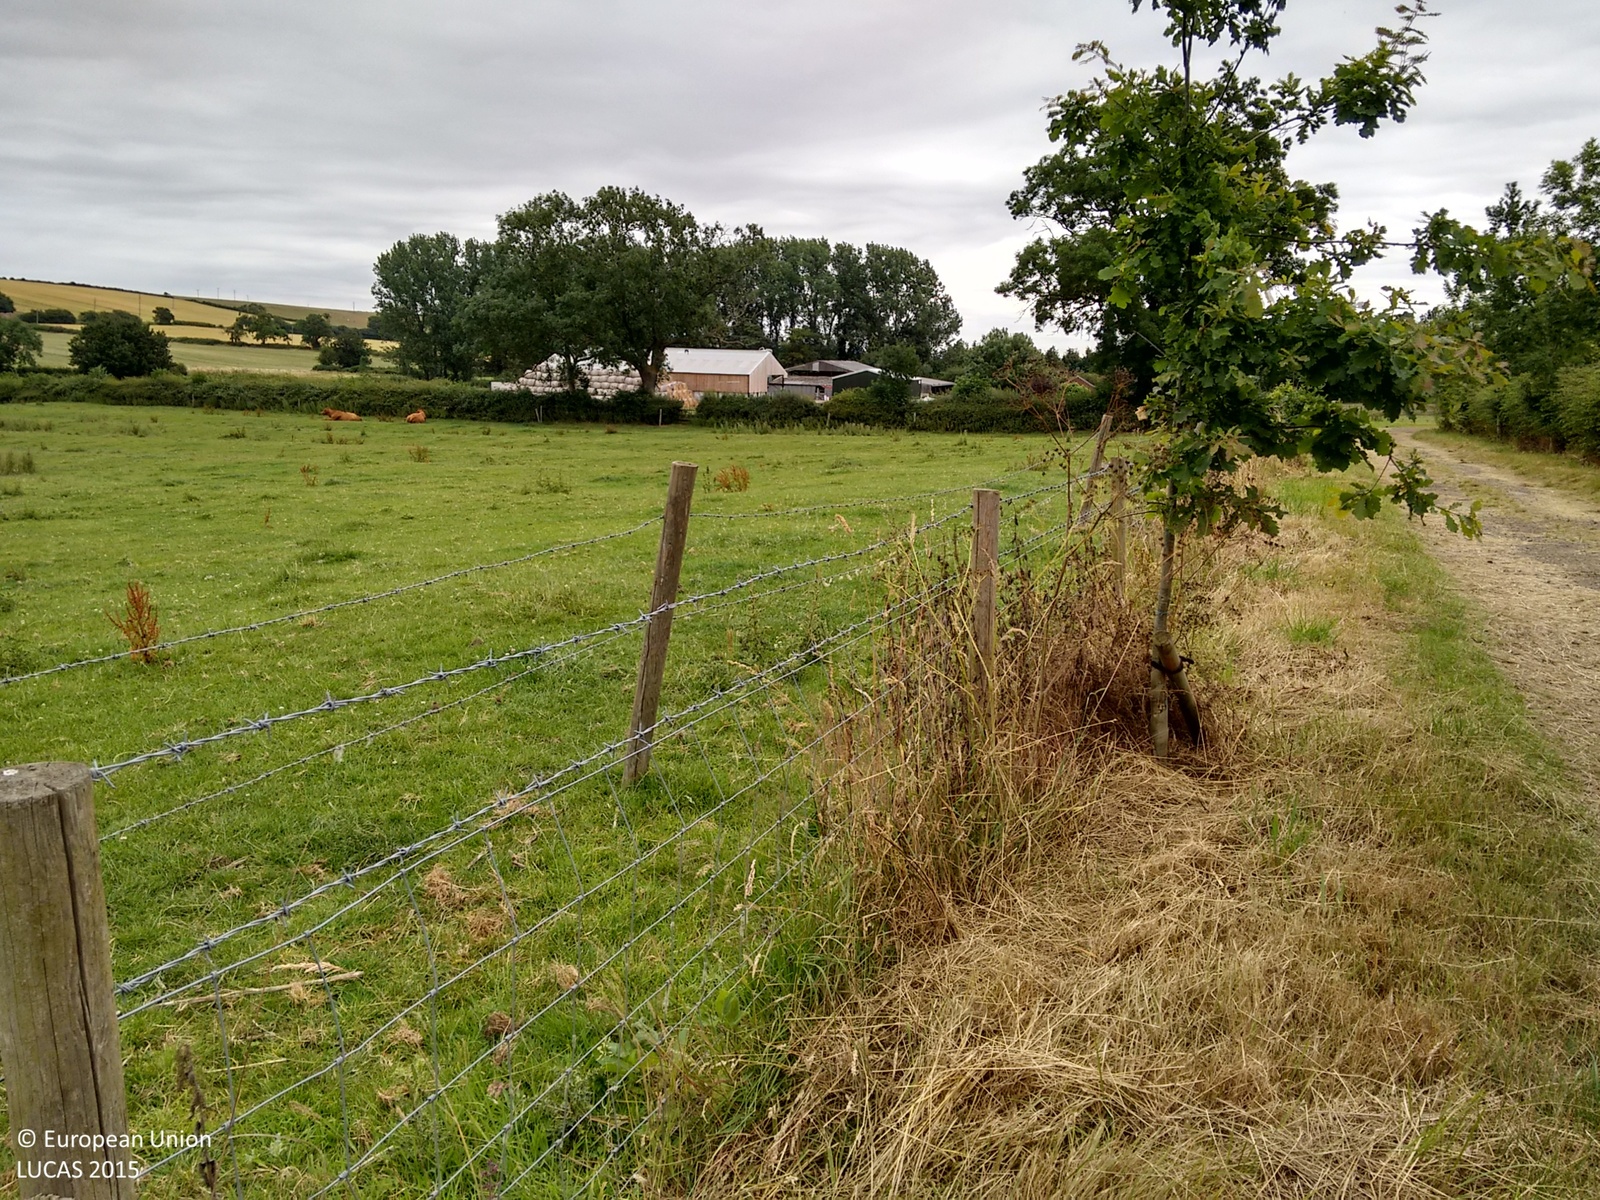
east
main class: Grassland
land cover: Grassland without tree/shrub cover
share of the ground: > 75 %
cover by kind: herbaceous plants 100 %
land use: Agriculture (excluding fallow land and kitchen gardens)
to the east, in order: Grassland without tree/shrub cover; Fences; Managed hedges; Single bushes/trees; Grass margins; Fences; Grassland without tree/shrub cover; Artificial constructions in urban areas; Broadleaved woodland
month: July
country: GB
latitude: 52.5266
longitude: -0.9062
